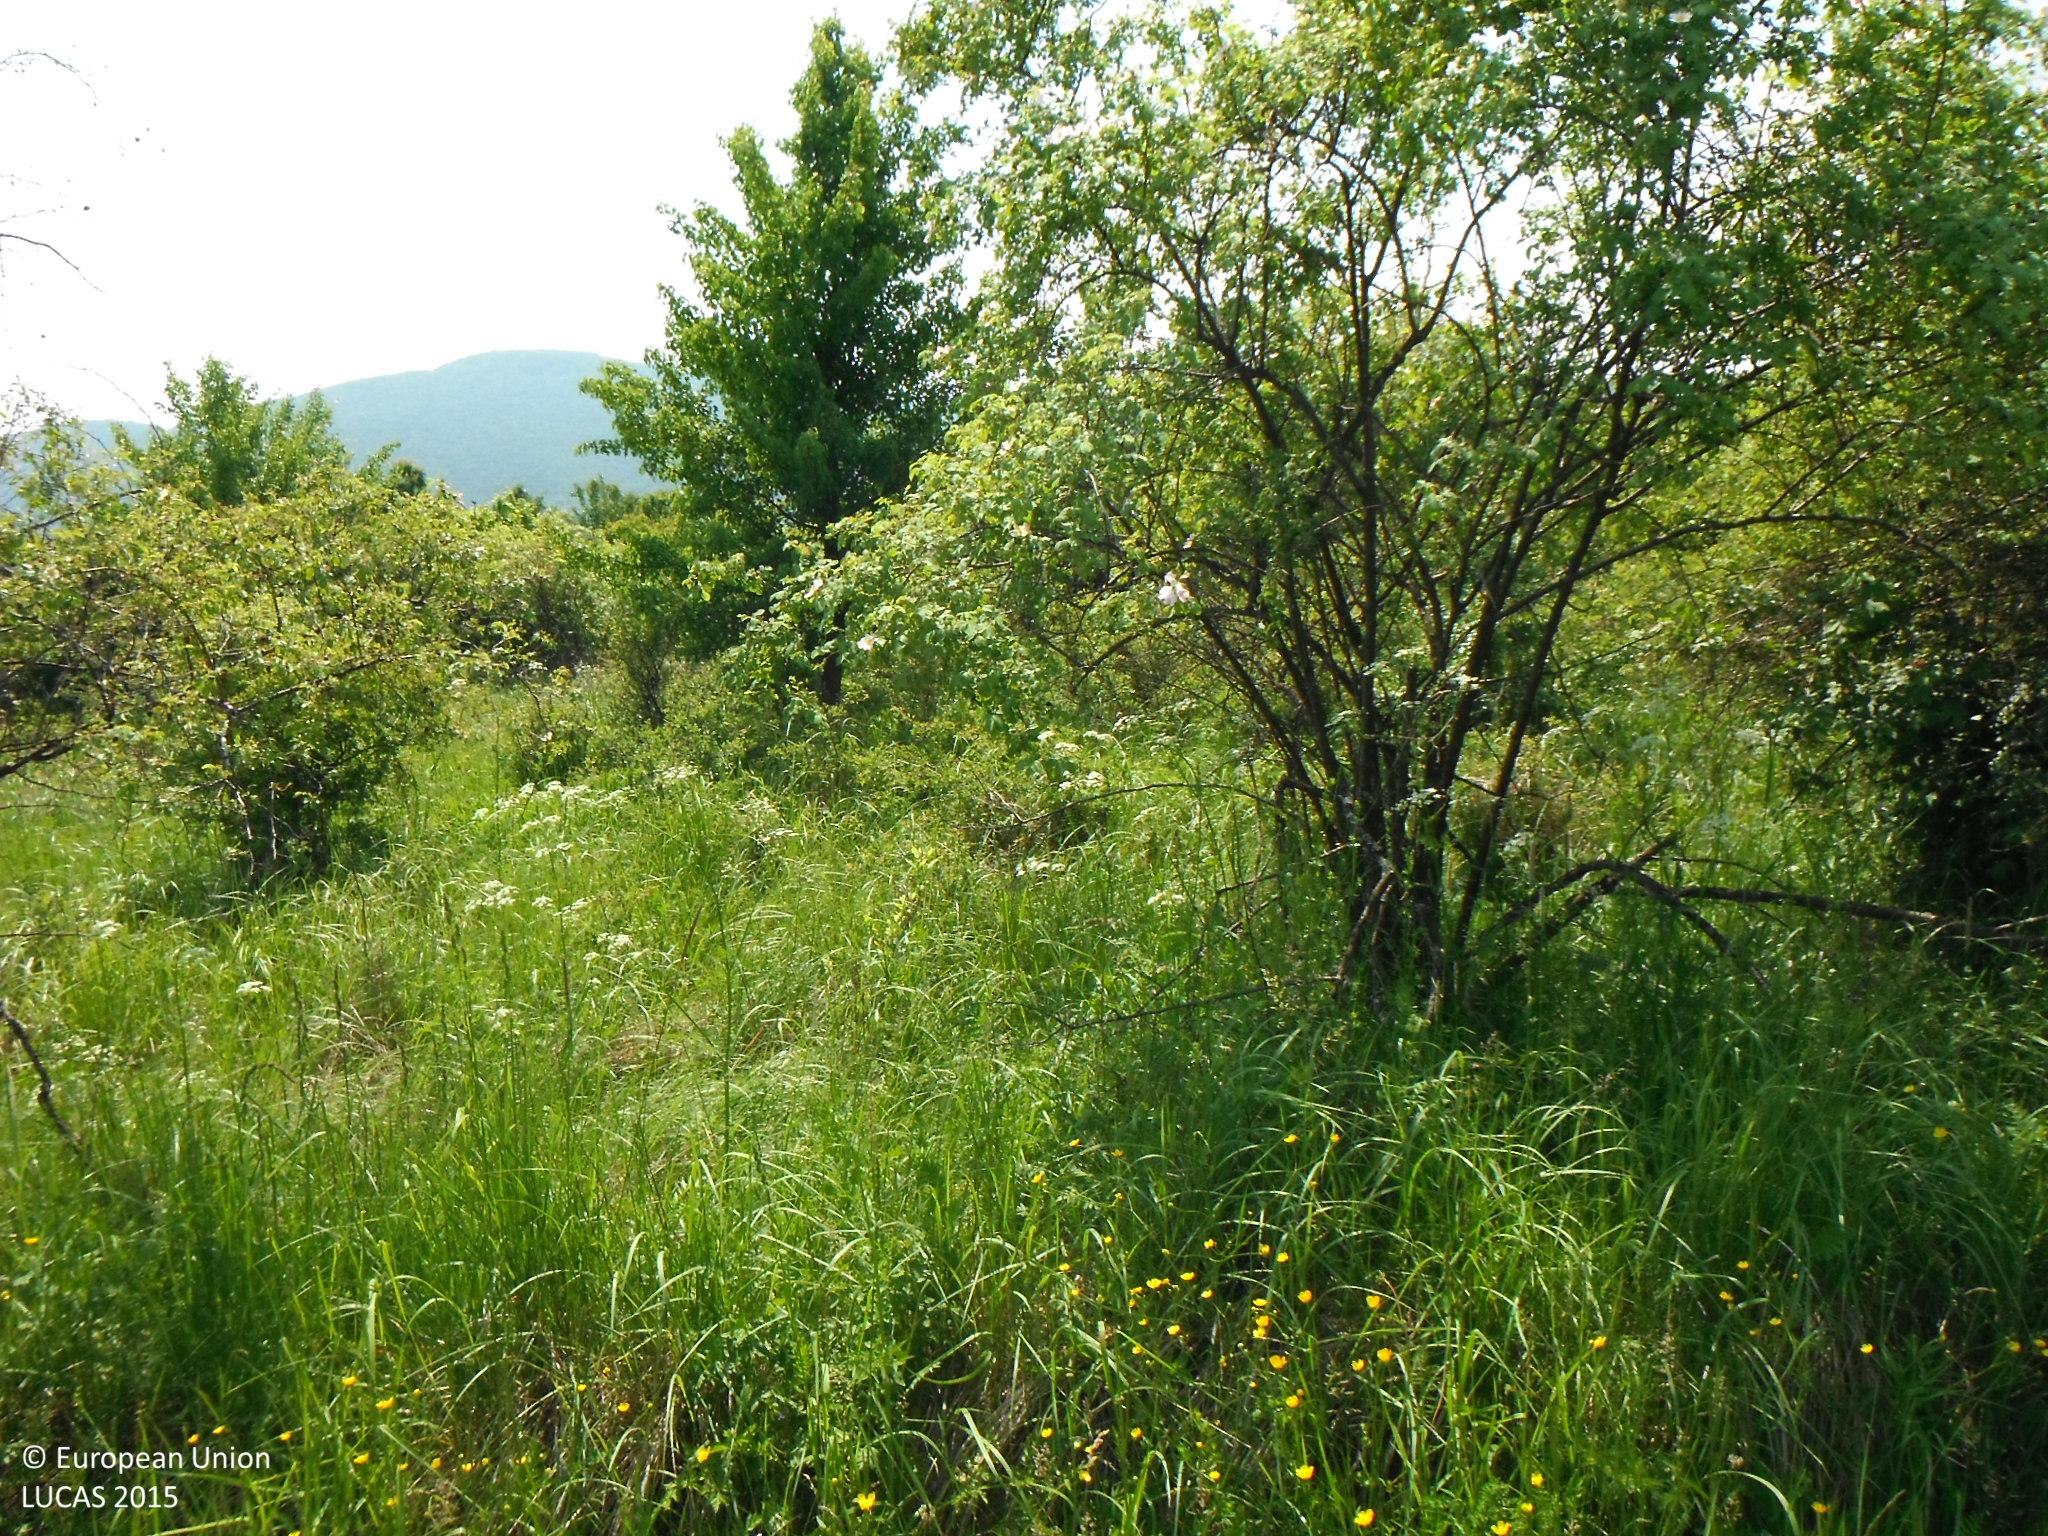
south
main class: Shrubland
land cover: Shrubland with sparse tree cover
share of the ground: > 75 %
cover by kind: shrubs 95 %, broadleaved forest trees 5 %
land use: Semi-natural and natural areas not in use
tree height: < 5 m
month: June
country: SK
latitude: 48.8280
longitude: 21.5869
